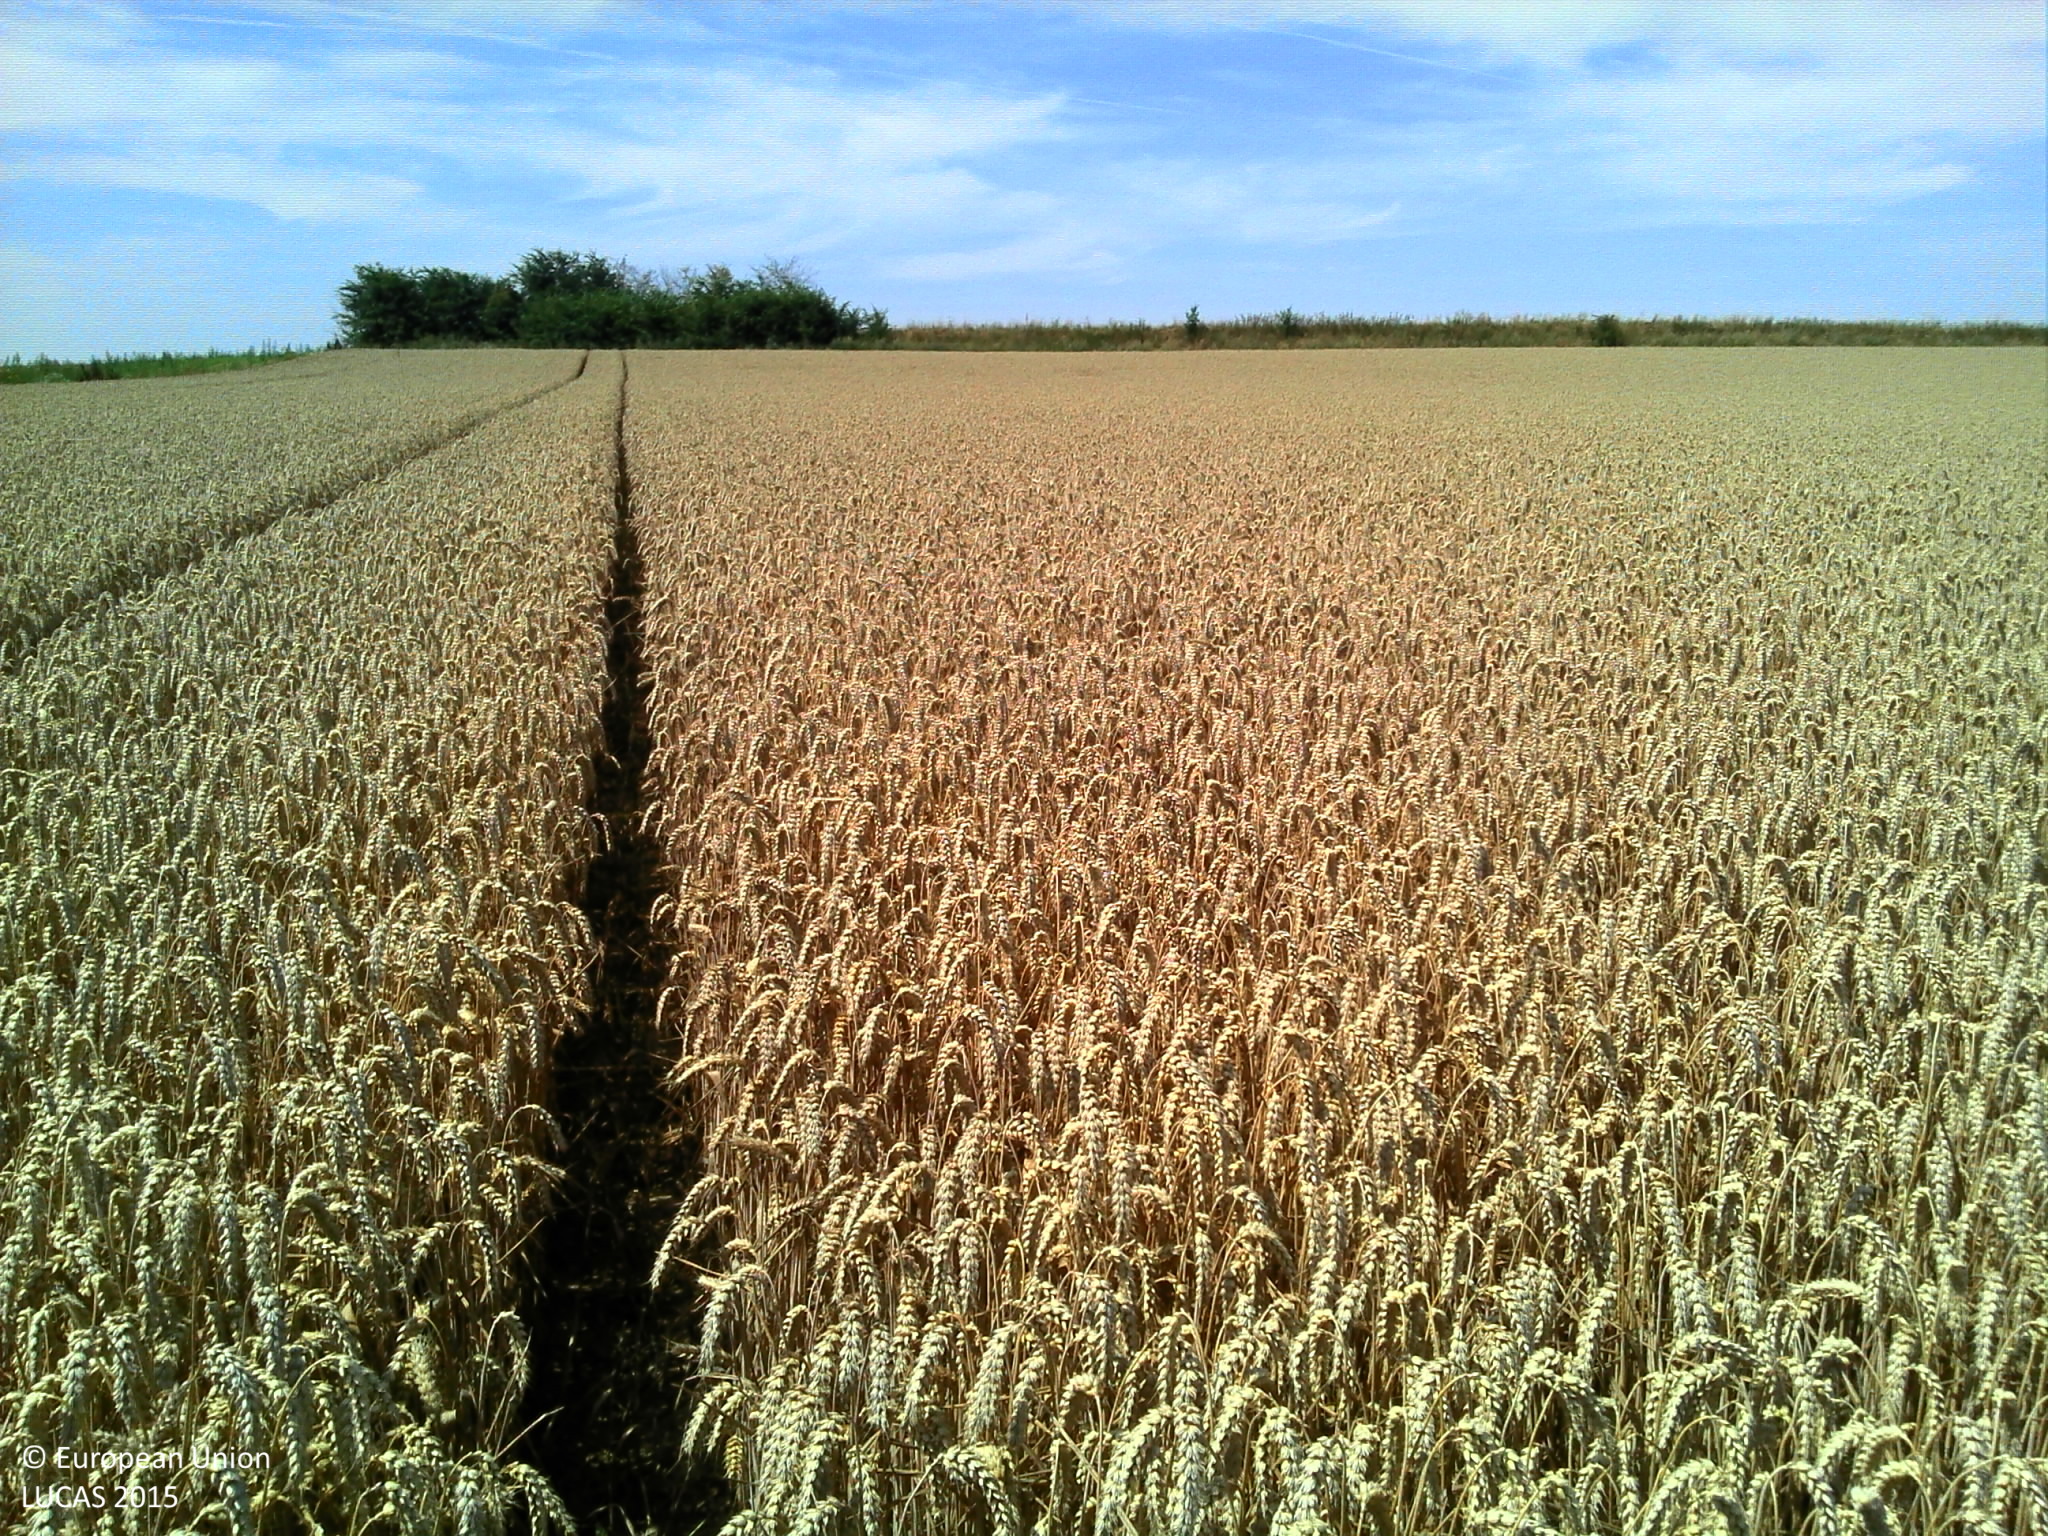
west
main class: Cropland
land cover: Common wheat
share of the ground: > 75 %
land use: Agriculture (excluding fallow land and kitchen gardens)
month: August
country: FR
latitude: 50.2998
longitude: 3.0975
